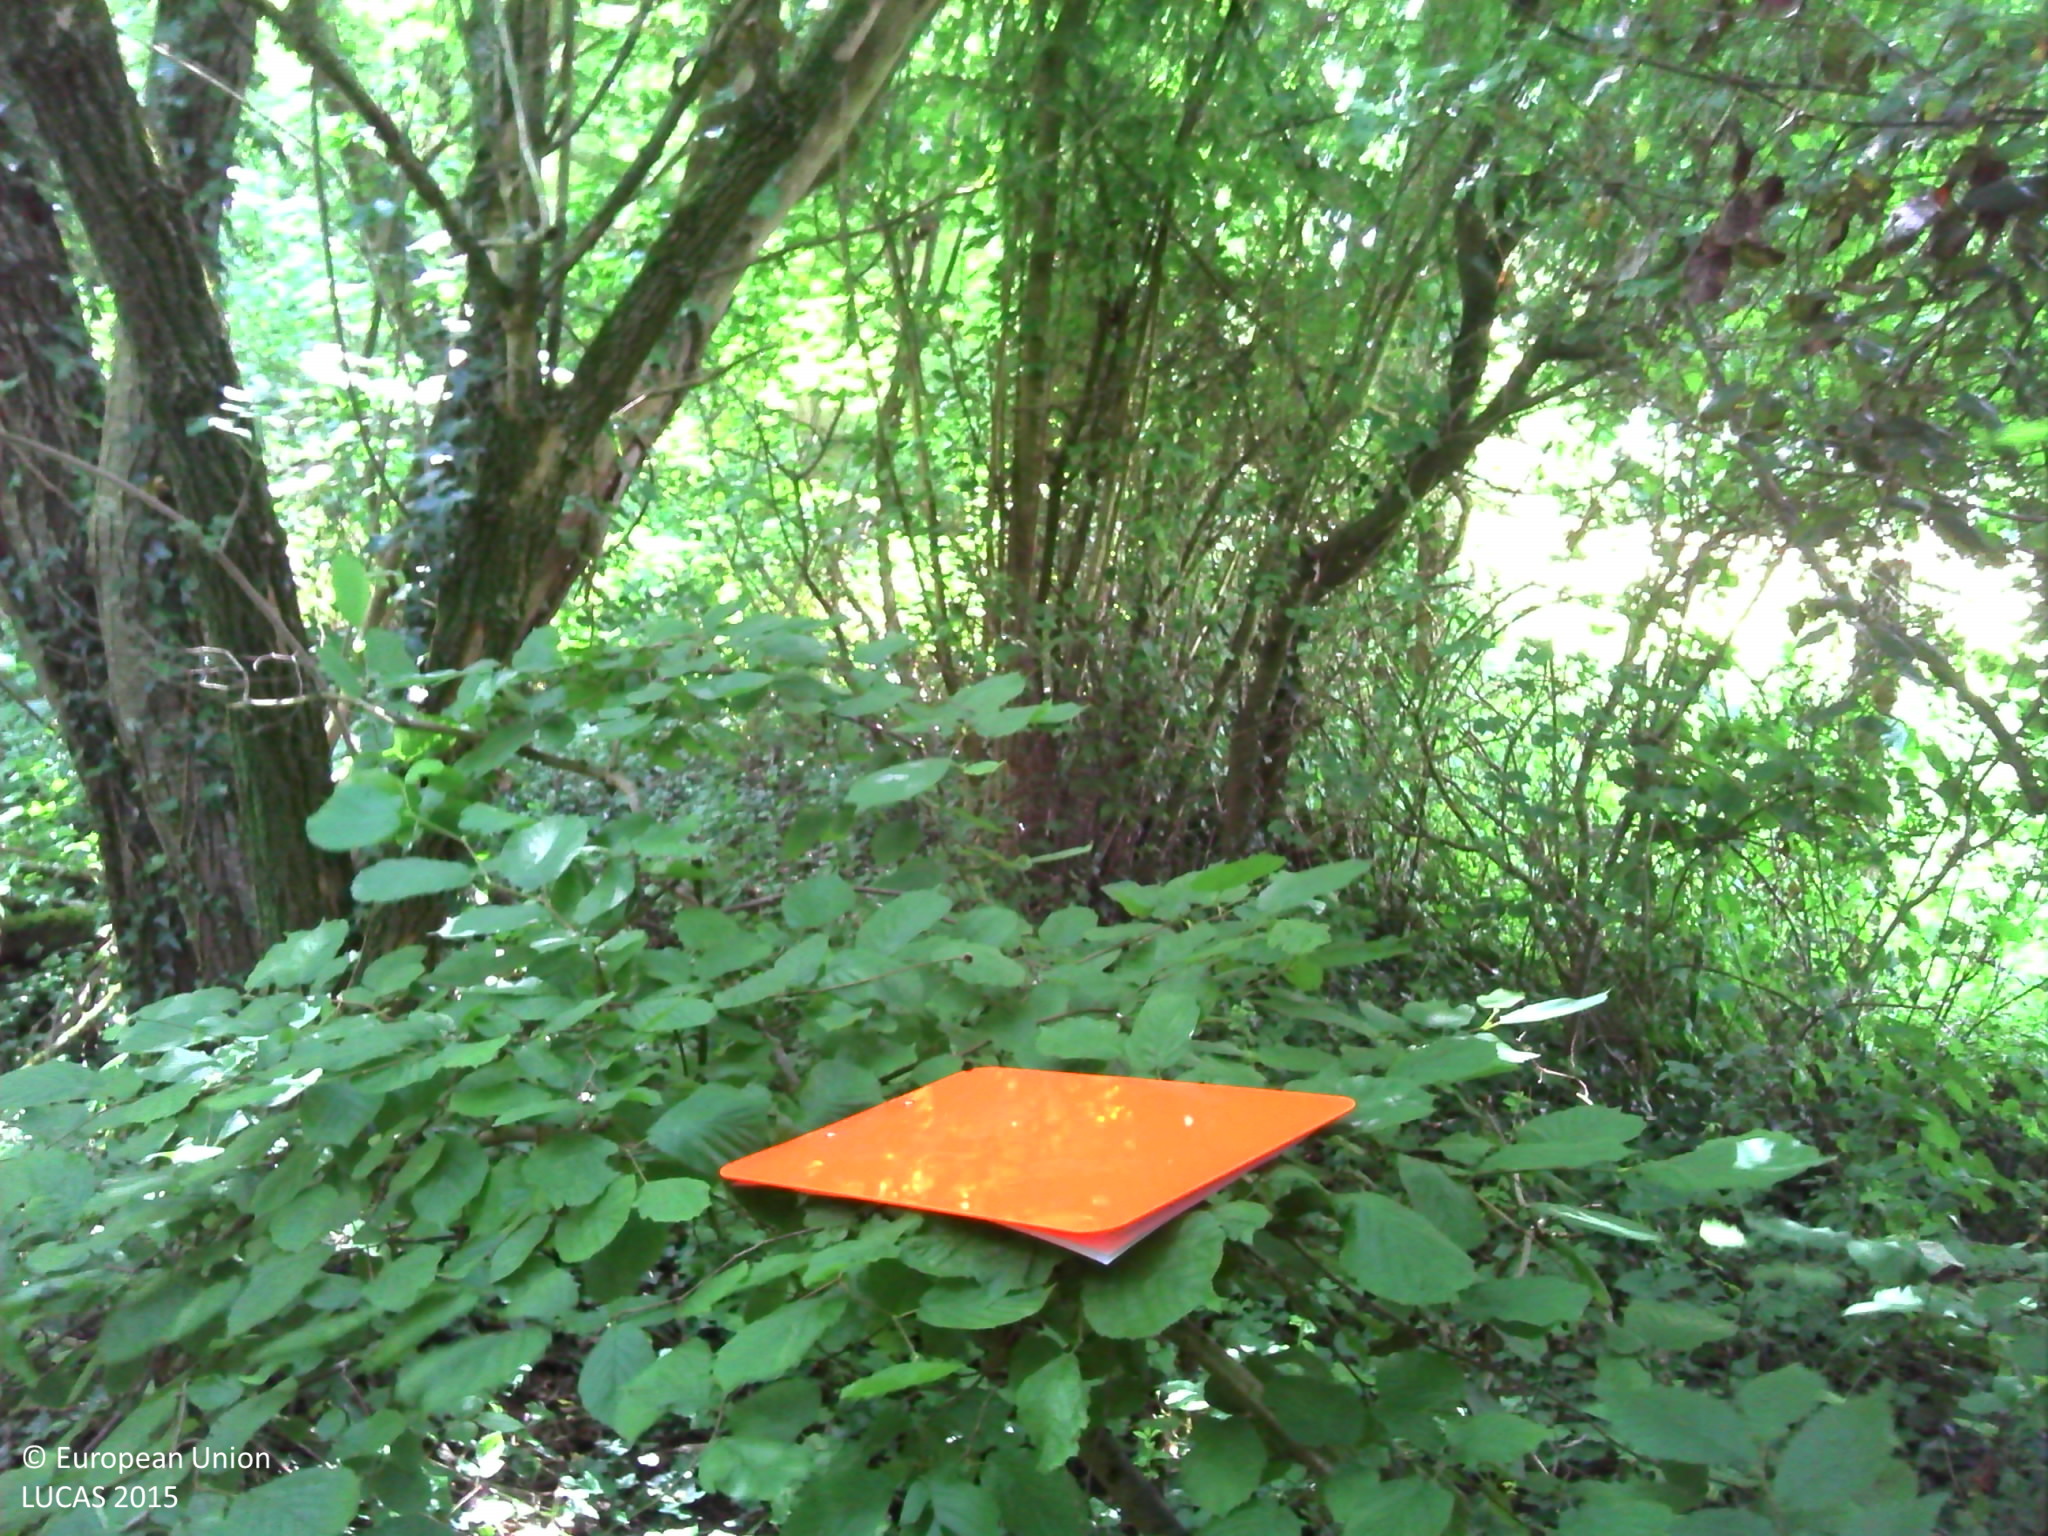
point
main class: Woodland
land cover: Broadleaved woodland
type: mesophytic deciduous forest
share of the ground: > 75 %
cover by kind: broadleaved forest trees 70 %, shrubs 20 %, herbaceous plants 10 %
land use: Semi-natural and natural areas not in use
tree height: > 5 m
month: July
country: FR
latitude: 48.9431
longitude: -0.2320
